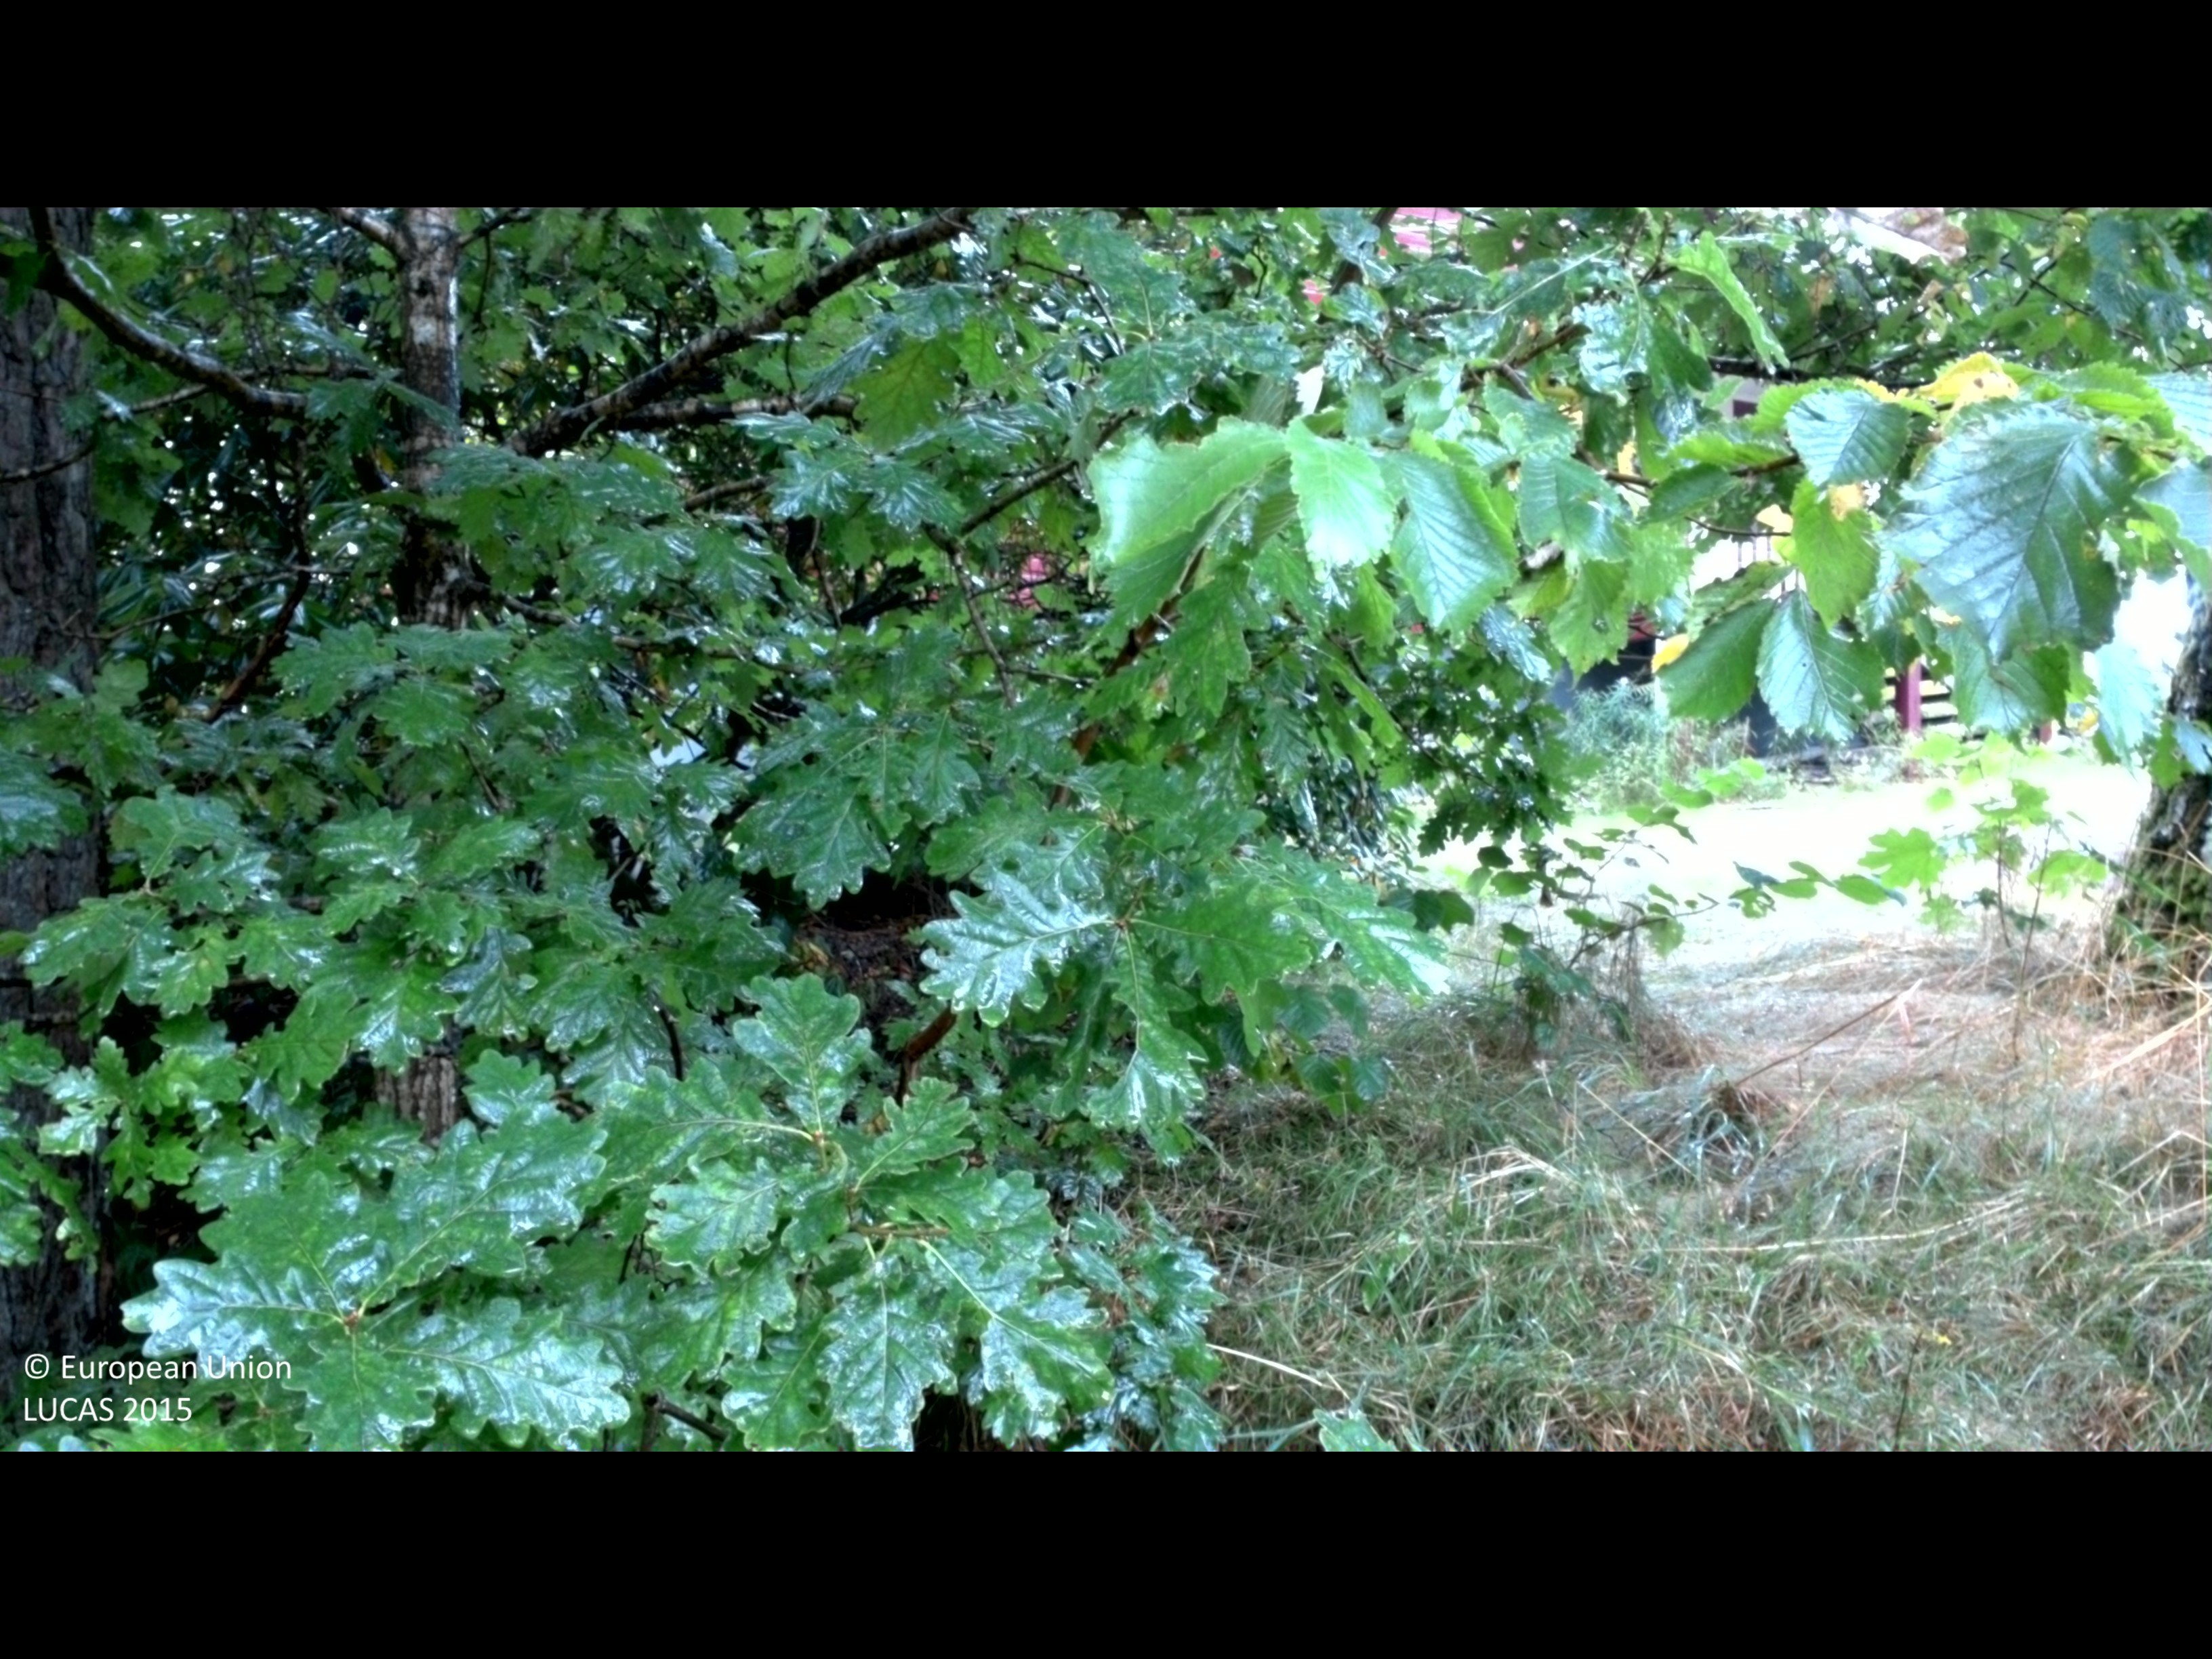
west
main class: Woodland
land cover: Pine dominated mixed woodland
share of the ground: 50 - 75 %
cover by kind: coniferous forest trees 45 %, herbaceous plants 25 %, broadleaved forest trees 20 %, shrubs 10 %
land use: Residential
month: August
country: SE
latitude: 56.9591
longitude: 13.1374
